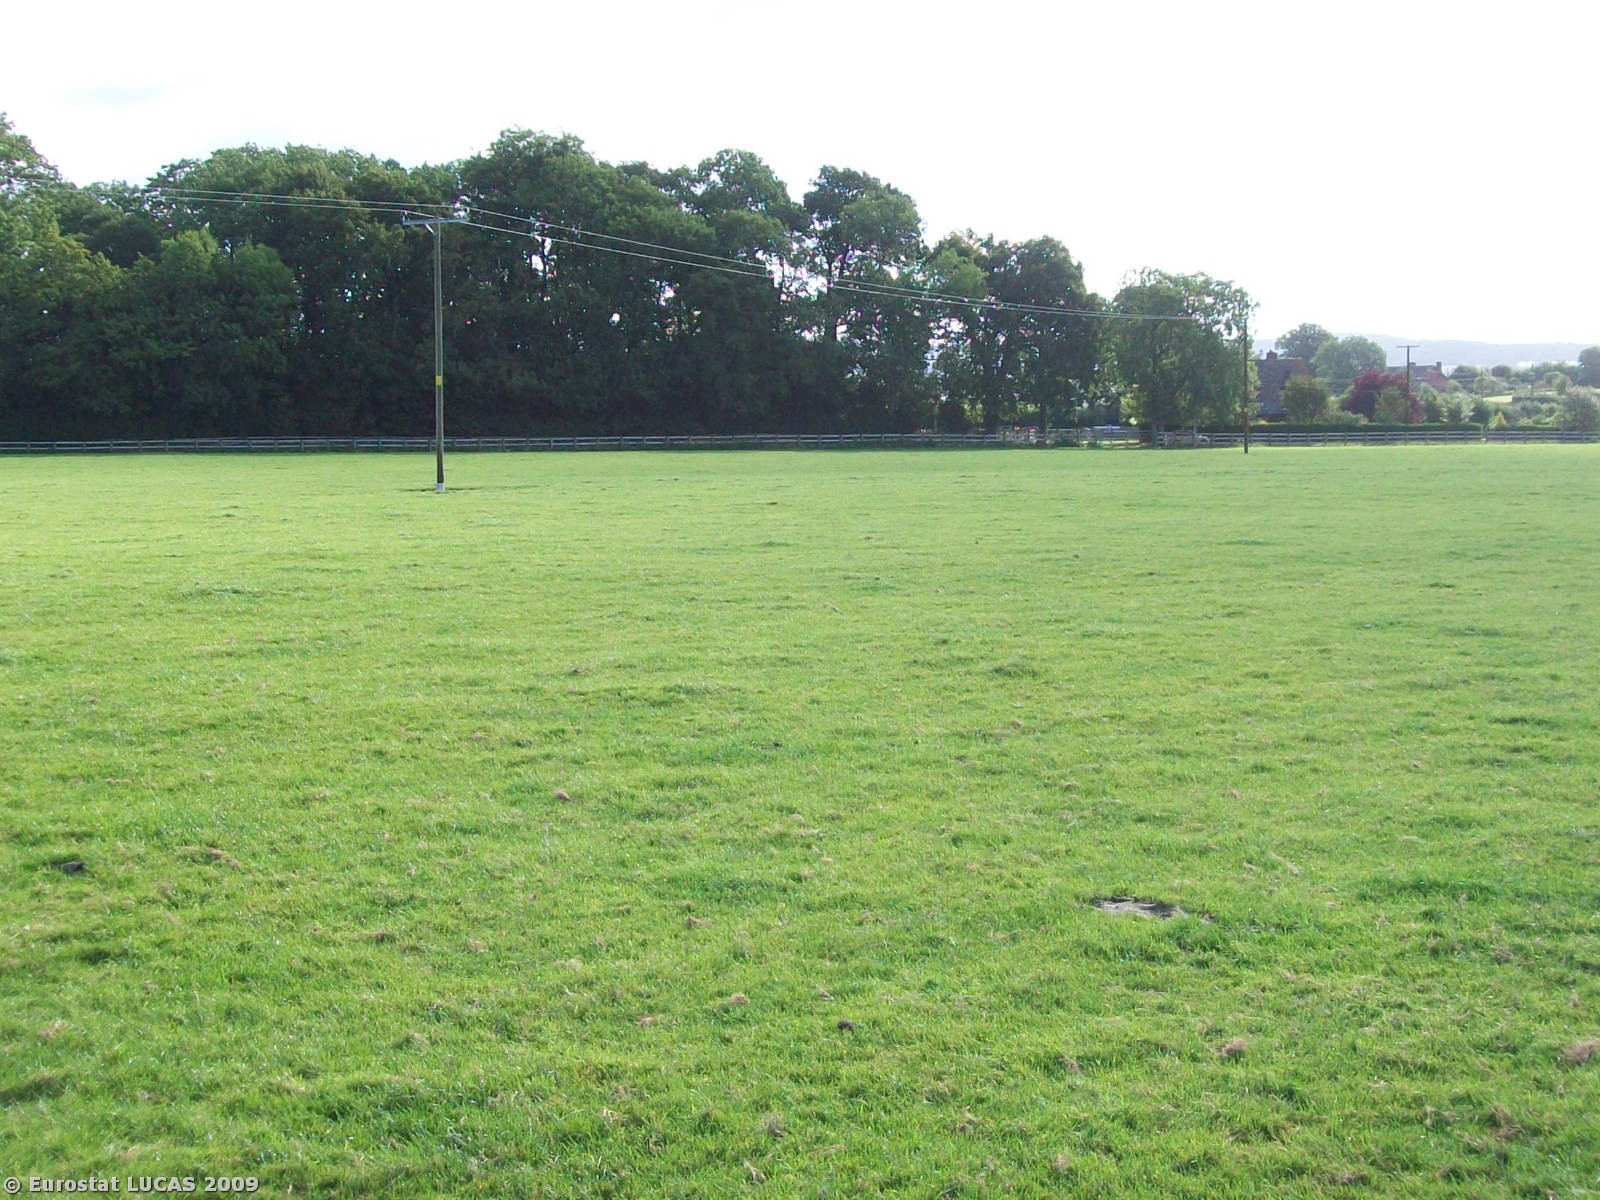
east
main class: Grassland
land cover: Grassland without tree/shrub cover
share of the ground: > 75 %
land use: Agriculture (excluding fallow land and kitchen gardens)
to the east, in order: Grassland without tree/shrub cover; Fences; Grass margins; Tracks; Grass margins; Fences; Broadleaved woodland; Fences; Grassland with sparse tree/shrub cover
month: September
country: GB
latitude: 52.0793
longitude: -2.4837
